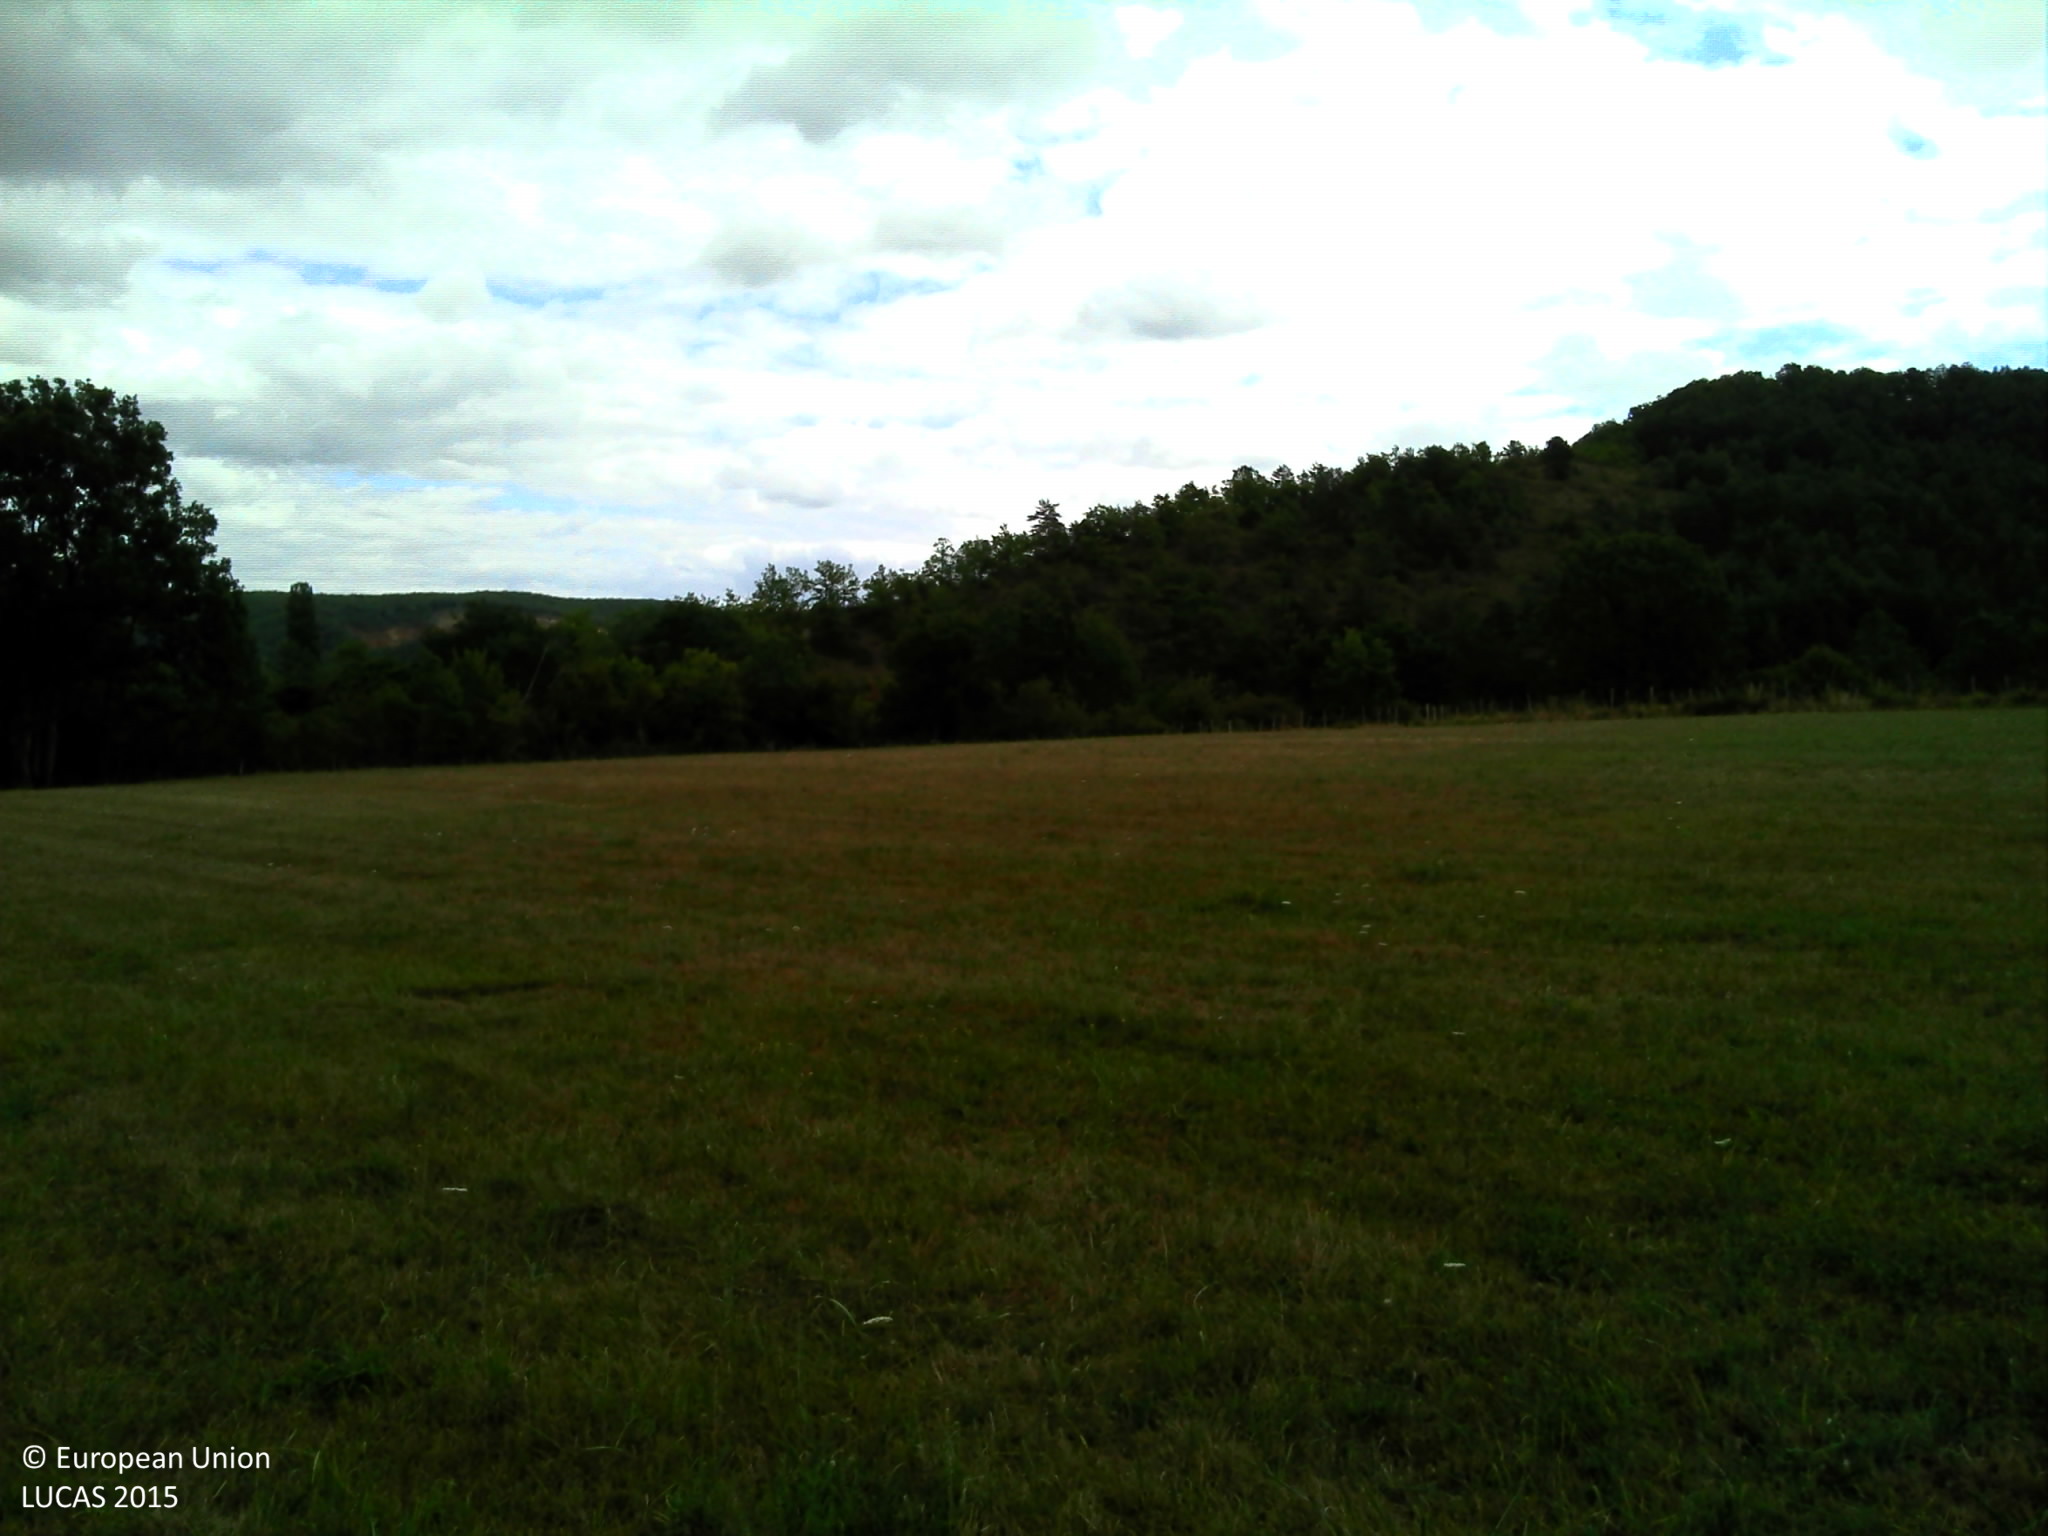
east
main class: Grassland
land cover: Grassland without tree/shrub cover
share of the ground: > 75 %
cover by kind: herbaceous plants 100 %
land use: Agriculture (excluding fallow land and kitchen gardens)
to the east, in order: Grassland without tree/shrub cover; Fences; Broadleaved woodland; Grassland without tree/shrub cover; Managed hedges; Grassland without tree/shrub cover; Abandoned hedges; Grassland without tree/shrub cover; Broadleaved woodland; Shrubland with sparse tree cover
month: July
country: FR
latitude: 44.8965
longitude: 0.9389
